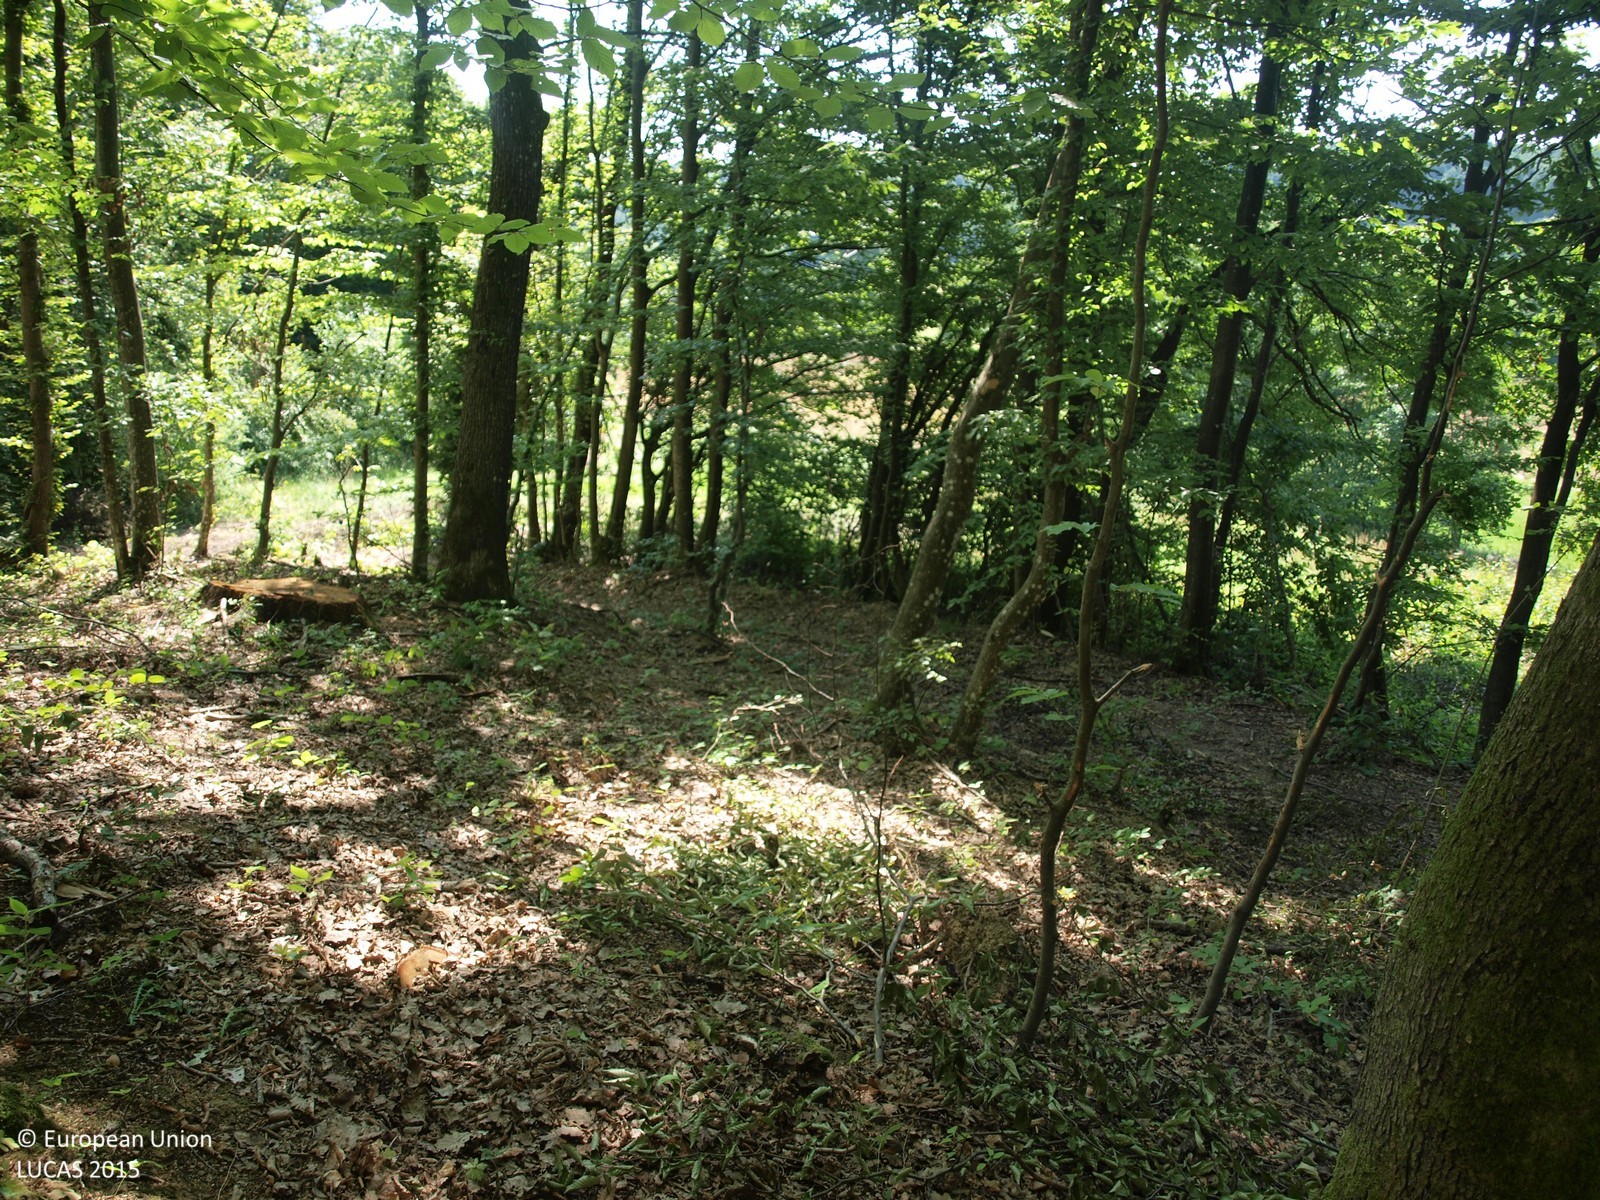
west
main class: Woodland
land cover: Broadleaved woodland
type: beech forest
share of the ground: > 75 %
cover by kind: broadleaved forest trees 100 %
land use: Forestry
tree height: > 5 m
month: July
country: HR
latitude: 45.7096
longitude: 15.7390
